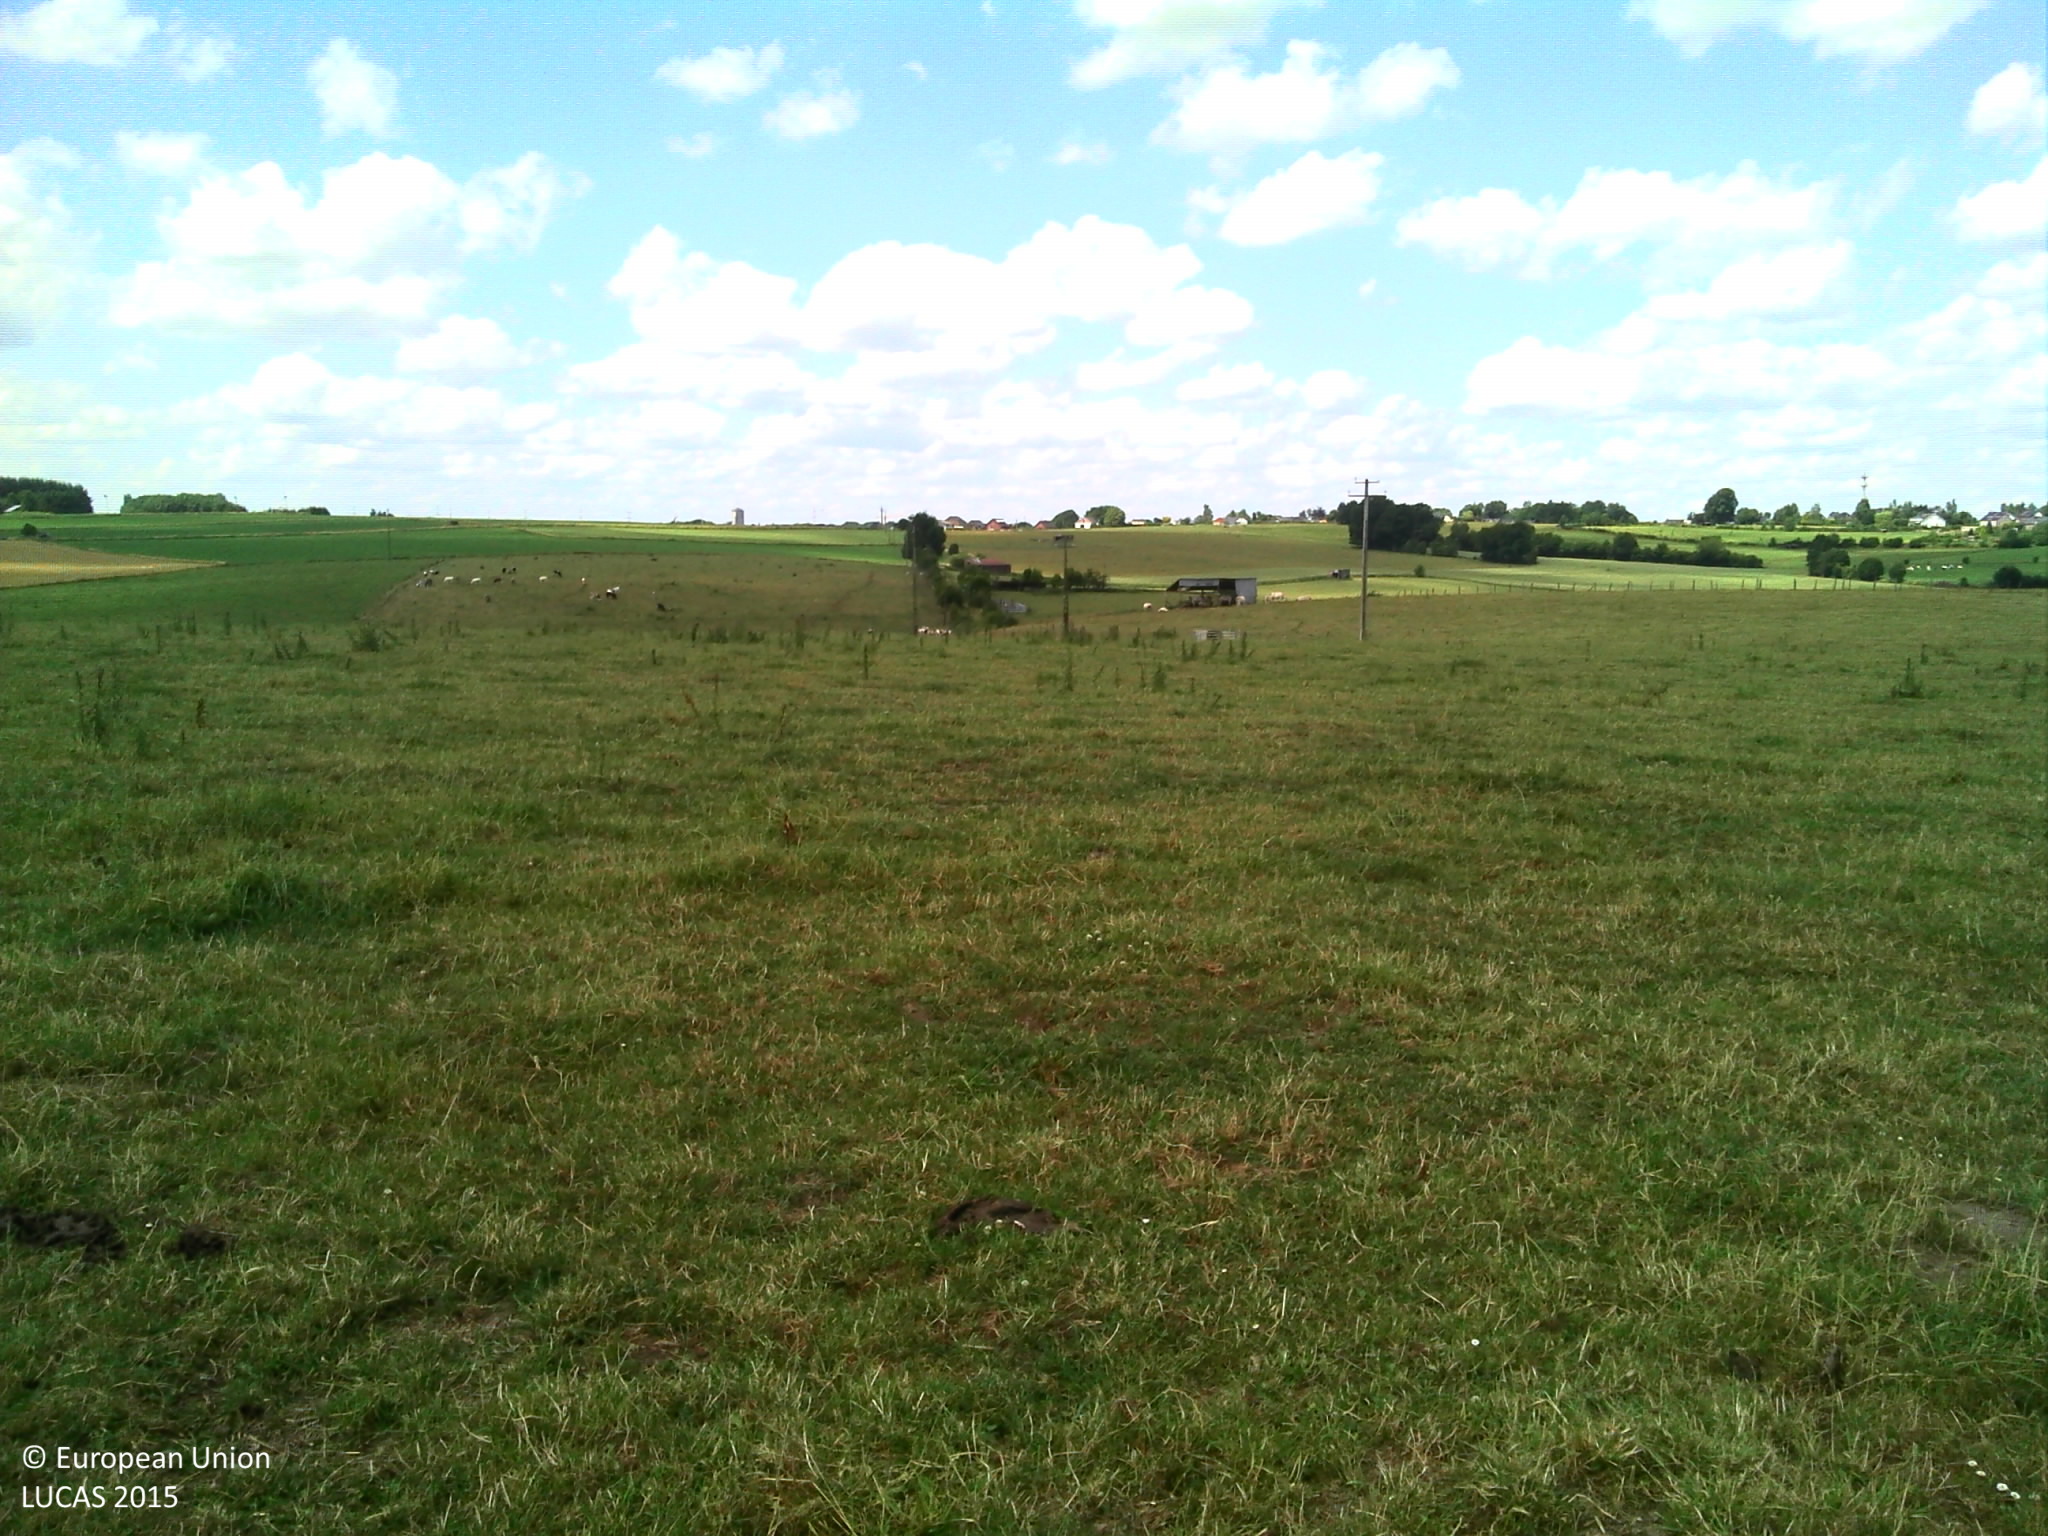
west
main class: Grassland
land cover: Grassland without tree/shrub cover
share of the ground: > 75 %
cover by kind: herbaceous plants 100 %
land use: Agriculture (excluding fallow land and kitchen gardens)
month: July
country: BE
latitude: 49.9968
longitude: 5.7439
